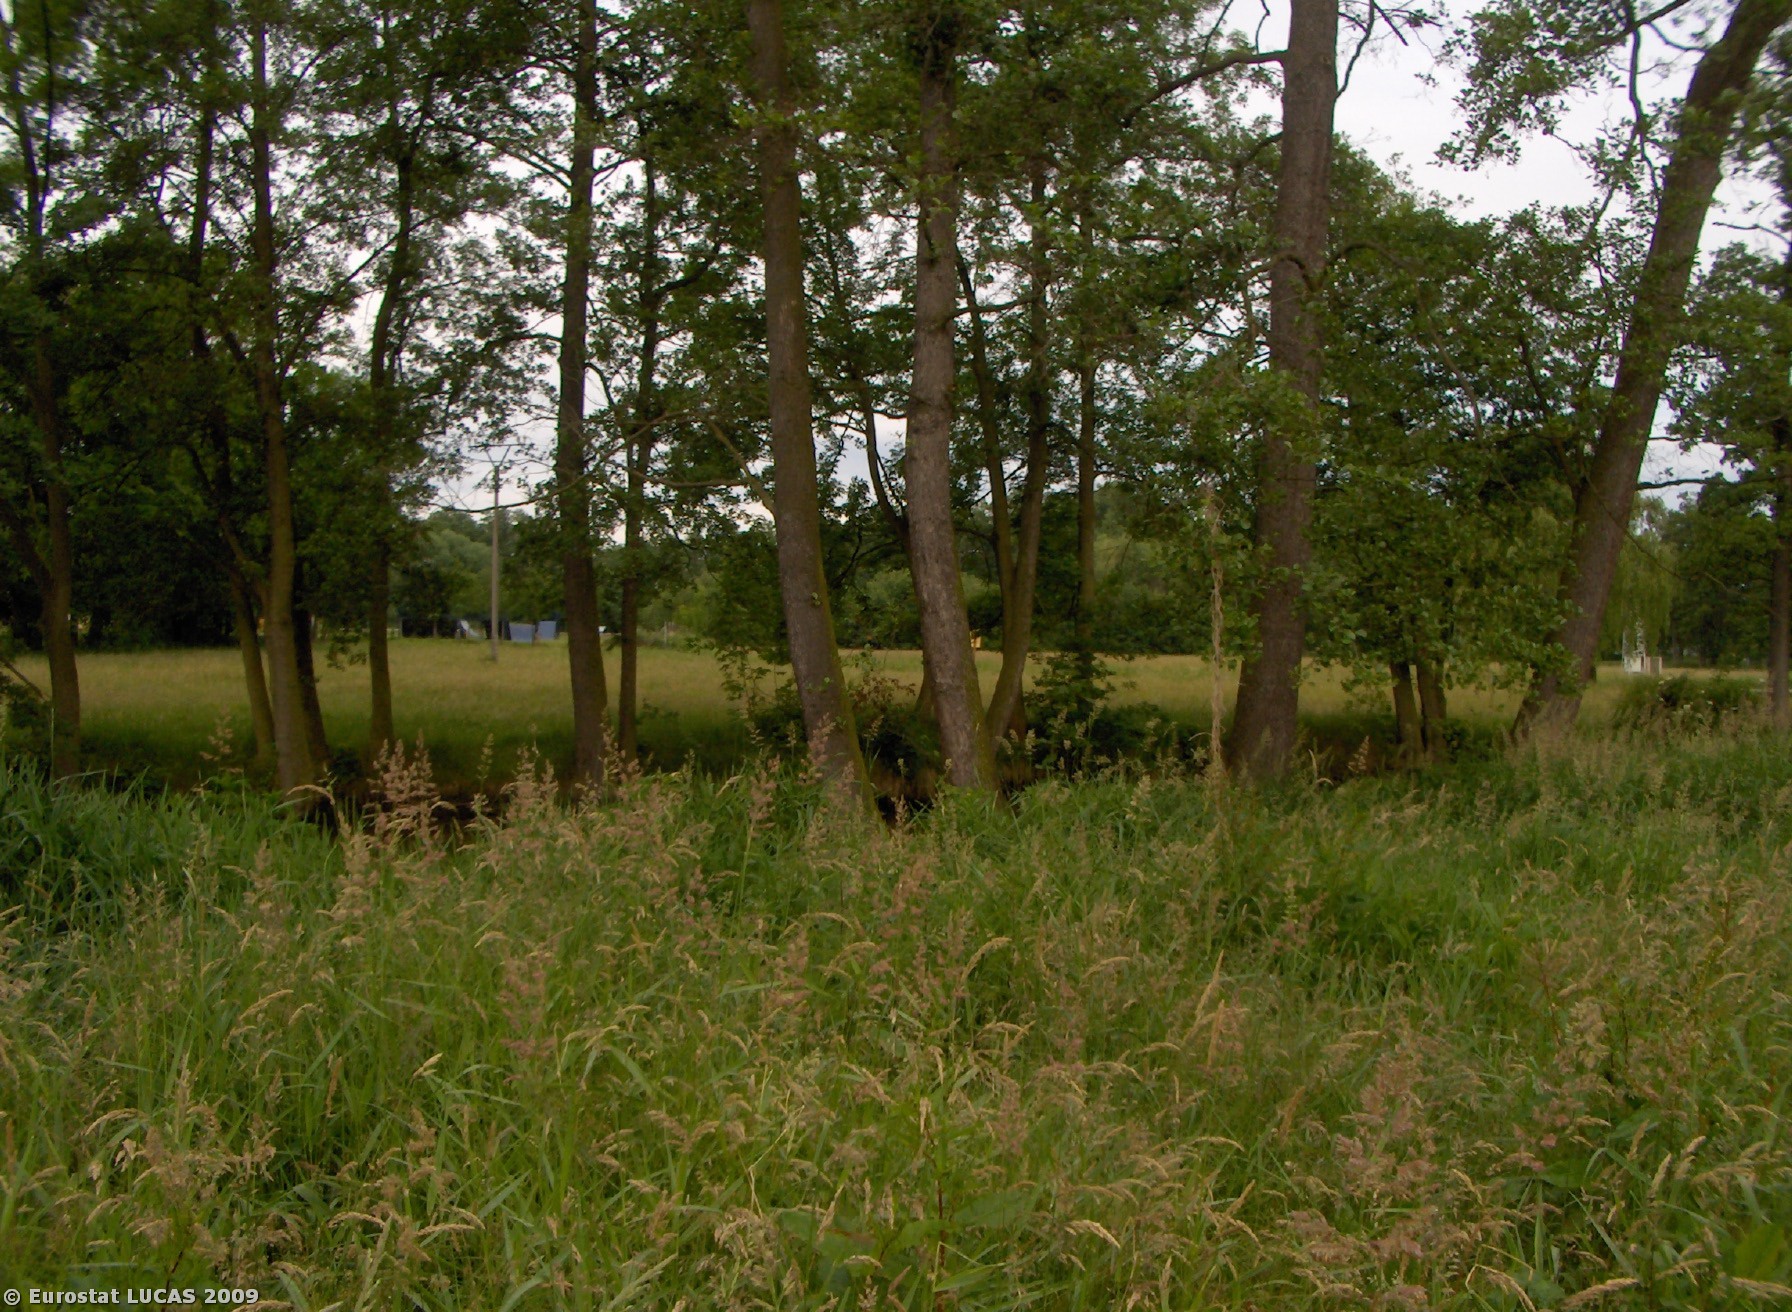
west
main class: Grassland
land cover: Grassland without tree/shrub cover
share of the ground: > 75 %
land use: Agriculture (excluding fallow land and kitchen gardens)
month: June
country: CZ
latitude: 49.1531
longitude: 14.1826
